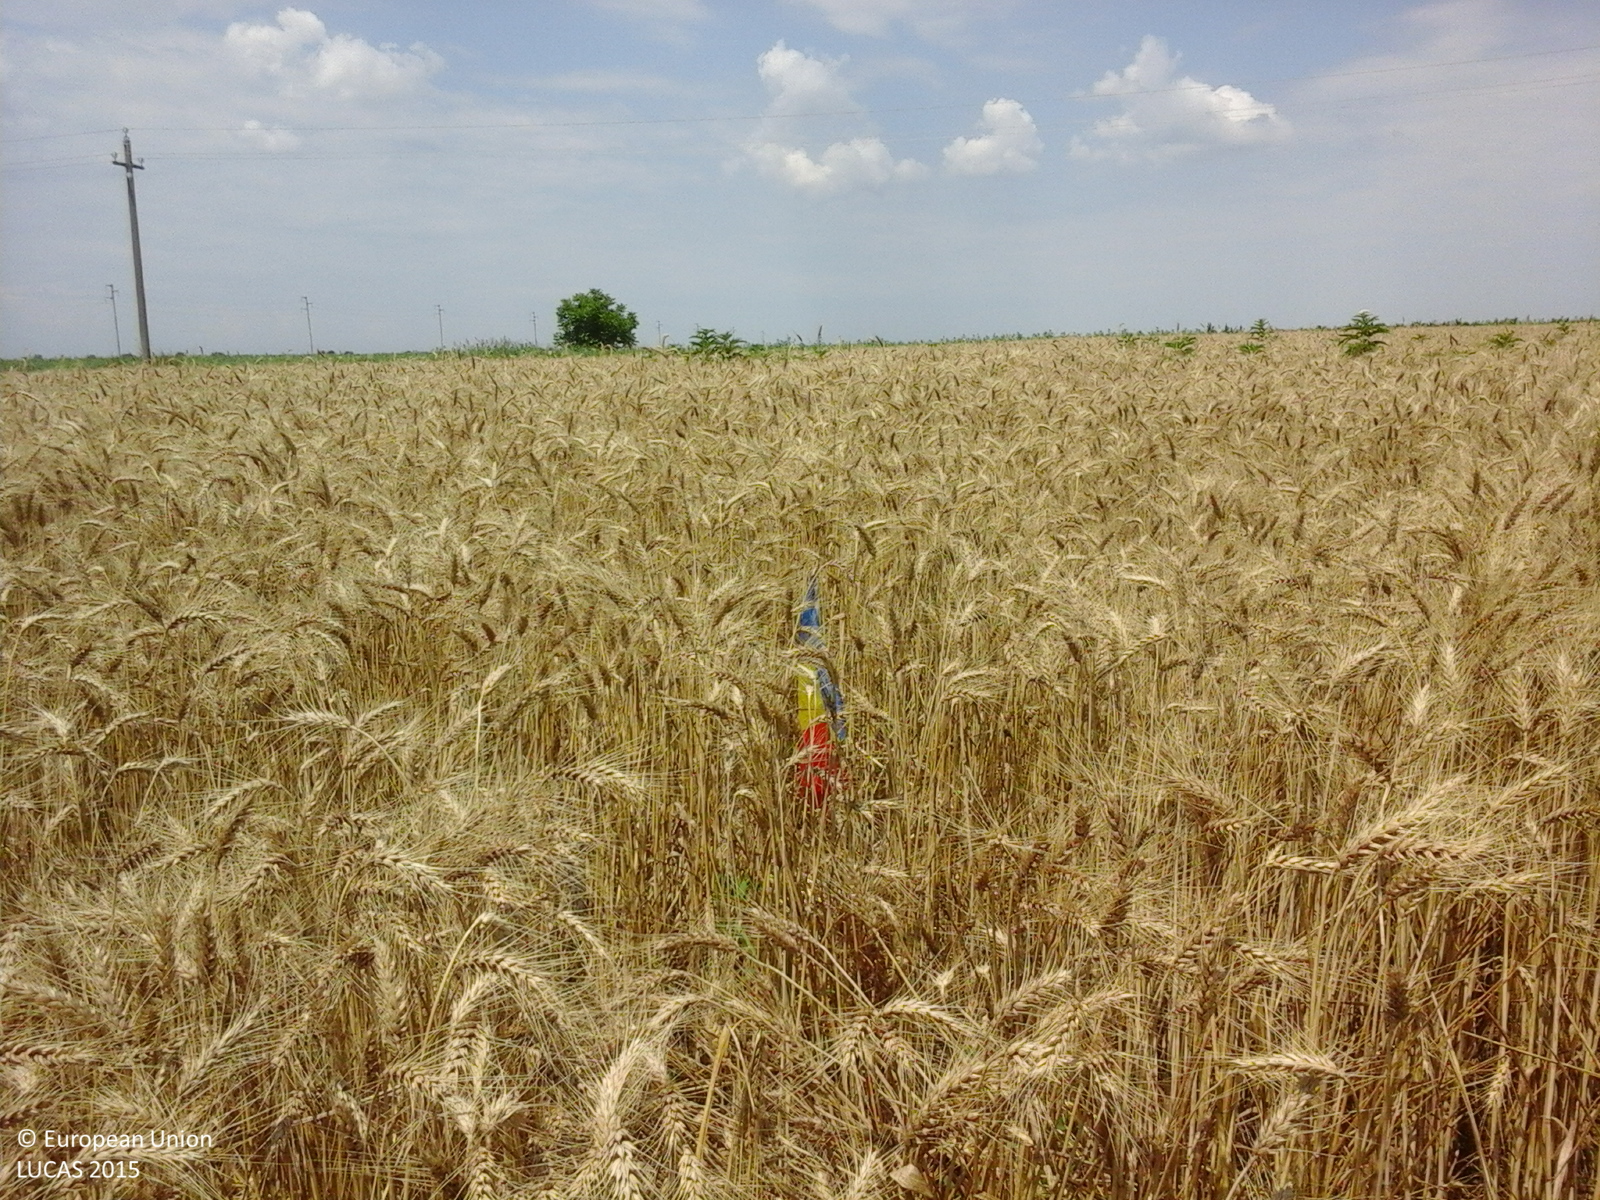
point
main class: Cropland
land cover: Common wheat
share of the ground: > 75 %
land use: Agriculture (excluding fallow land and kitchen gardens)
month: June
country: RO
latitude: 44.1244
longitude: 26.3670
